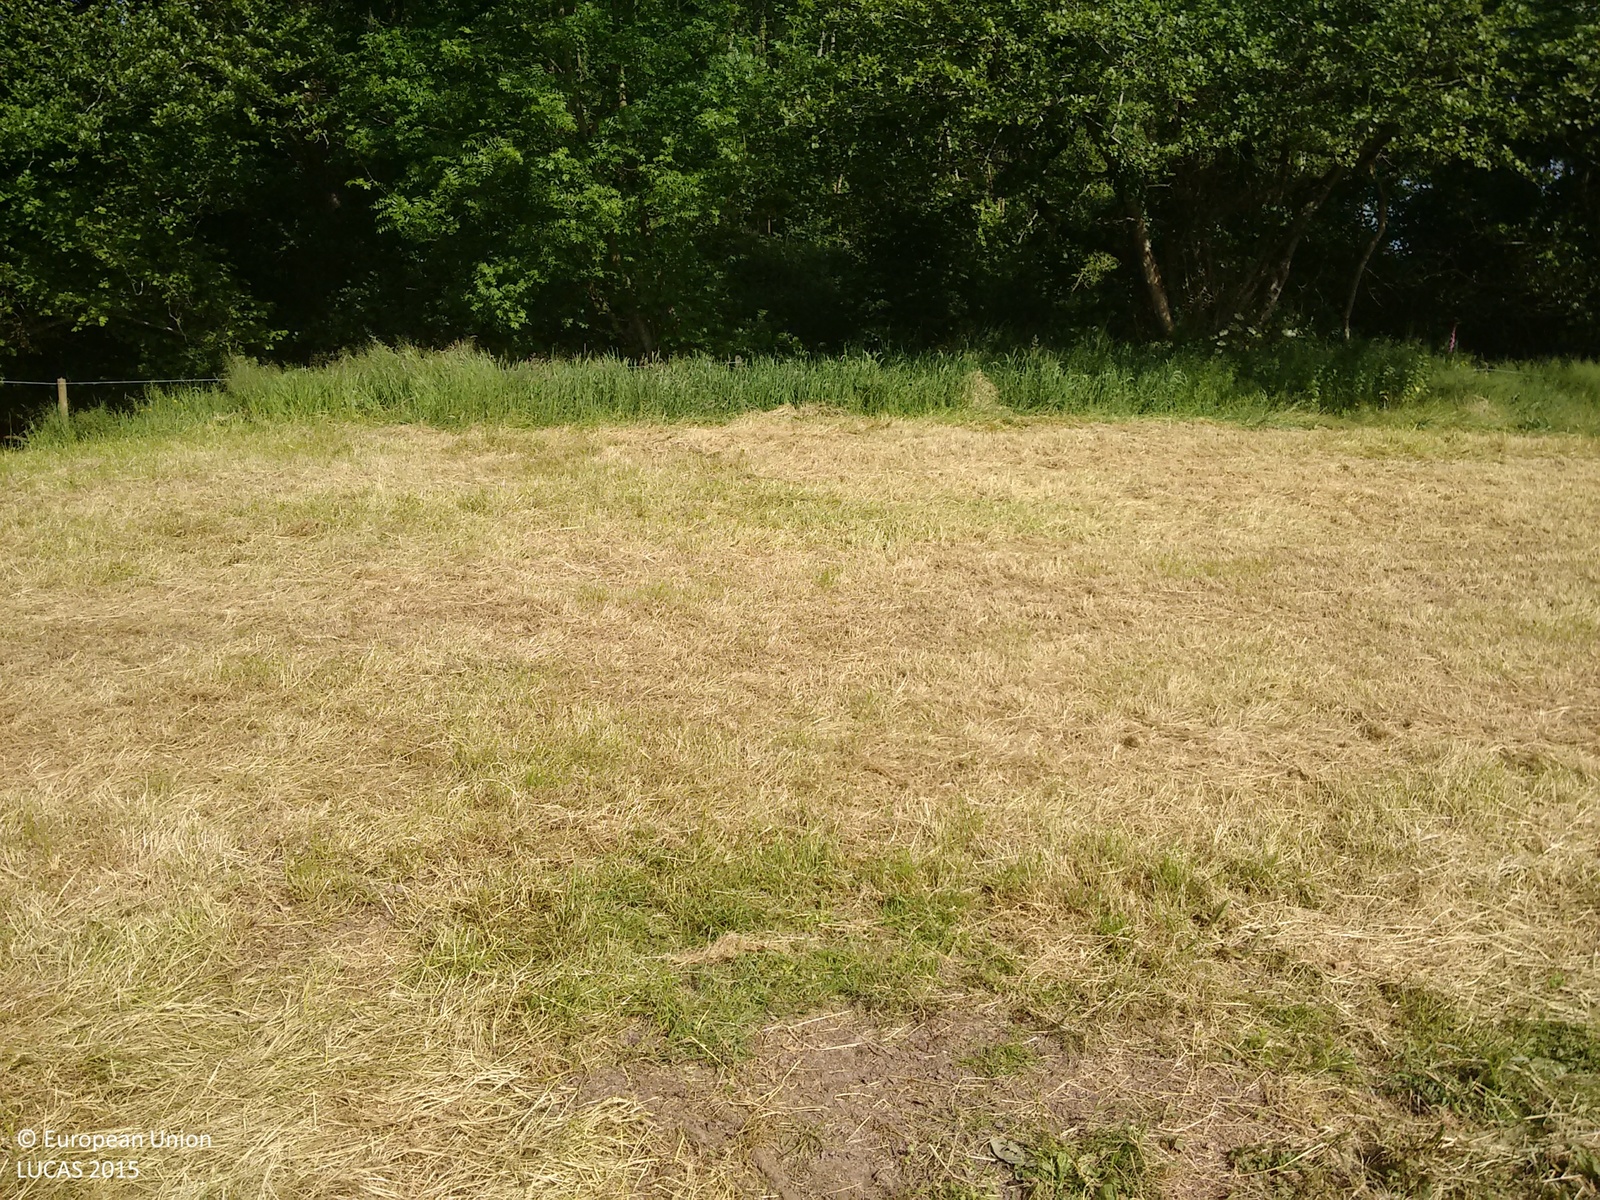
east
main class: Grassland
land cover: Grassland without tree/shrub cover
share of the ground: > 75 %
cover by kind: herbaceous plants 100 %
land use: Agriculture (excluding fallow land and kitchen gardens)
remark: Harvested field
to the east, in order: Grassland without tree/shrub cover; Fences; Broadleaved woodland; Inland fresh running water; Broadleaved woodland; Paved roads, cycling and walking lanes; Broadleaved woodland; Fences; Grassland without tree/shrub cover; Fences; Grassland without tree/shrub cover; Artificial constructions in urban areas; Grassland without tree/shrub cover; Fences; Grassland without tree/shrub cover
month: June
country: IE
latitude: 51.9443
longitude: -7.9970
